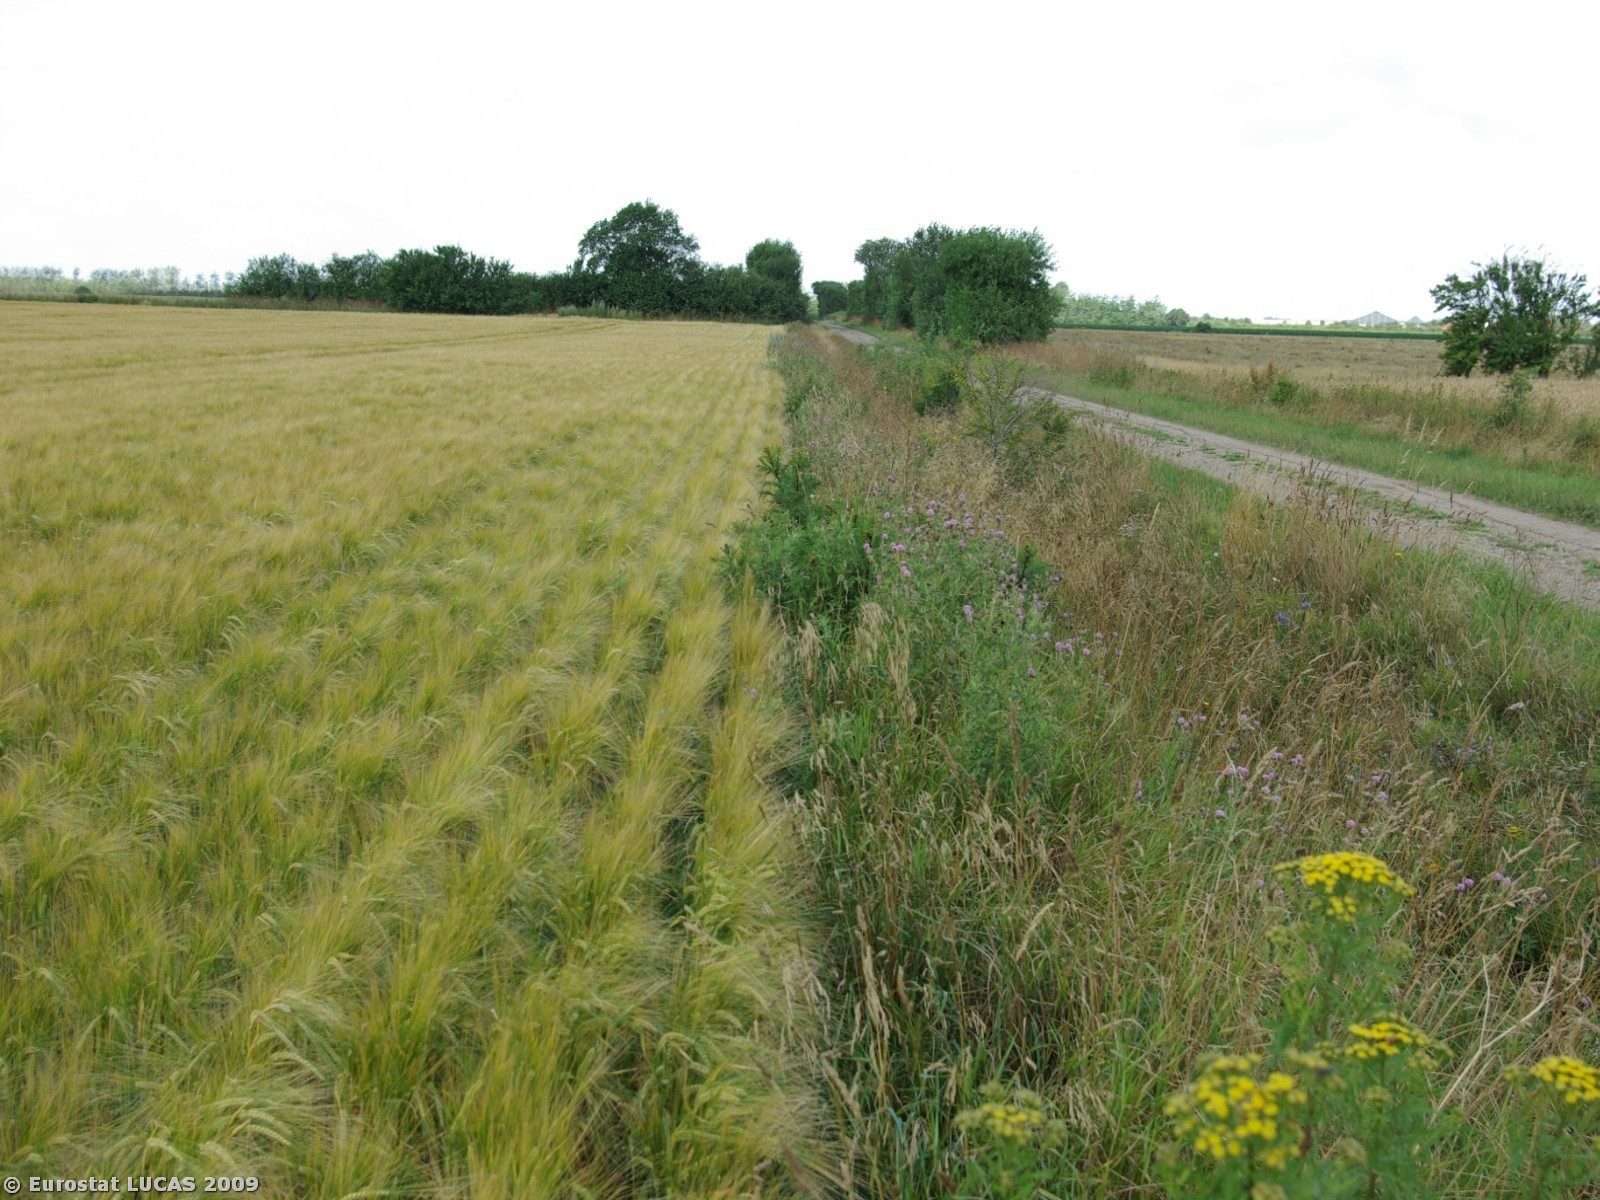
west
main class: Cropland
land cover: Barley
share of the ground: > 75 %
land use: Agriculture (excluding fallow land and kitchen gardens)
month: July
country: DK
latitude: 54.9957
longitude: 8.7973
